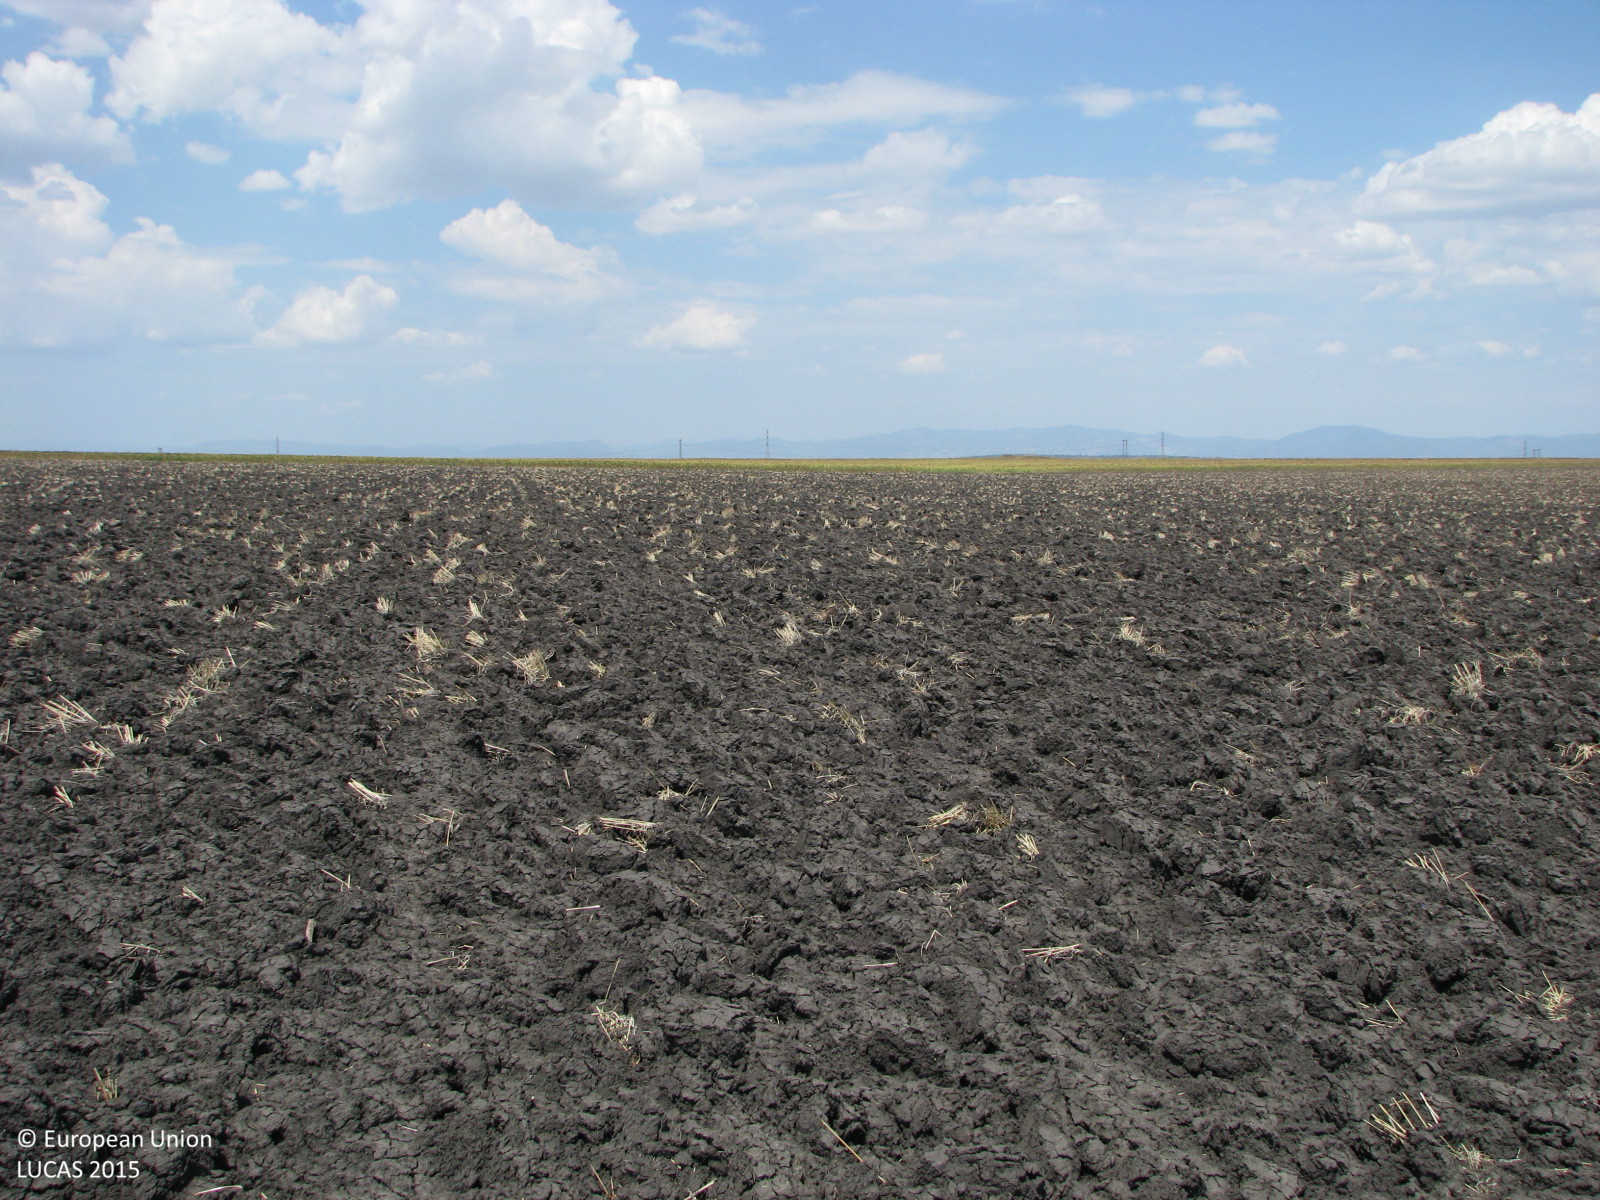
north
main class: Cropland
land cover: Common wheat
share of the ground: < 10 %
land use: Agriculture (excluding fallow land and kitchen gardens)
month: August
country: BG
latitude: 42.4184
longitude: 26.4600
